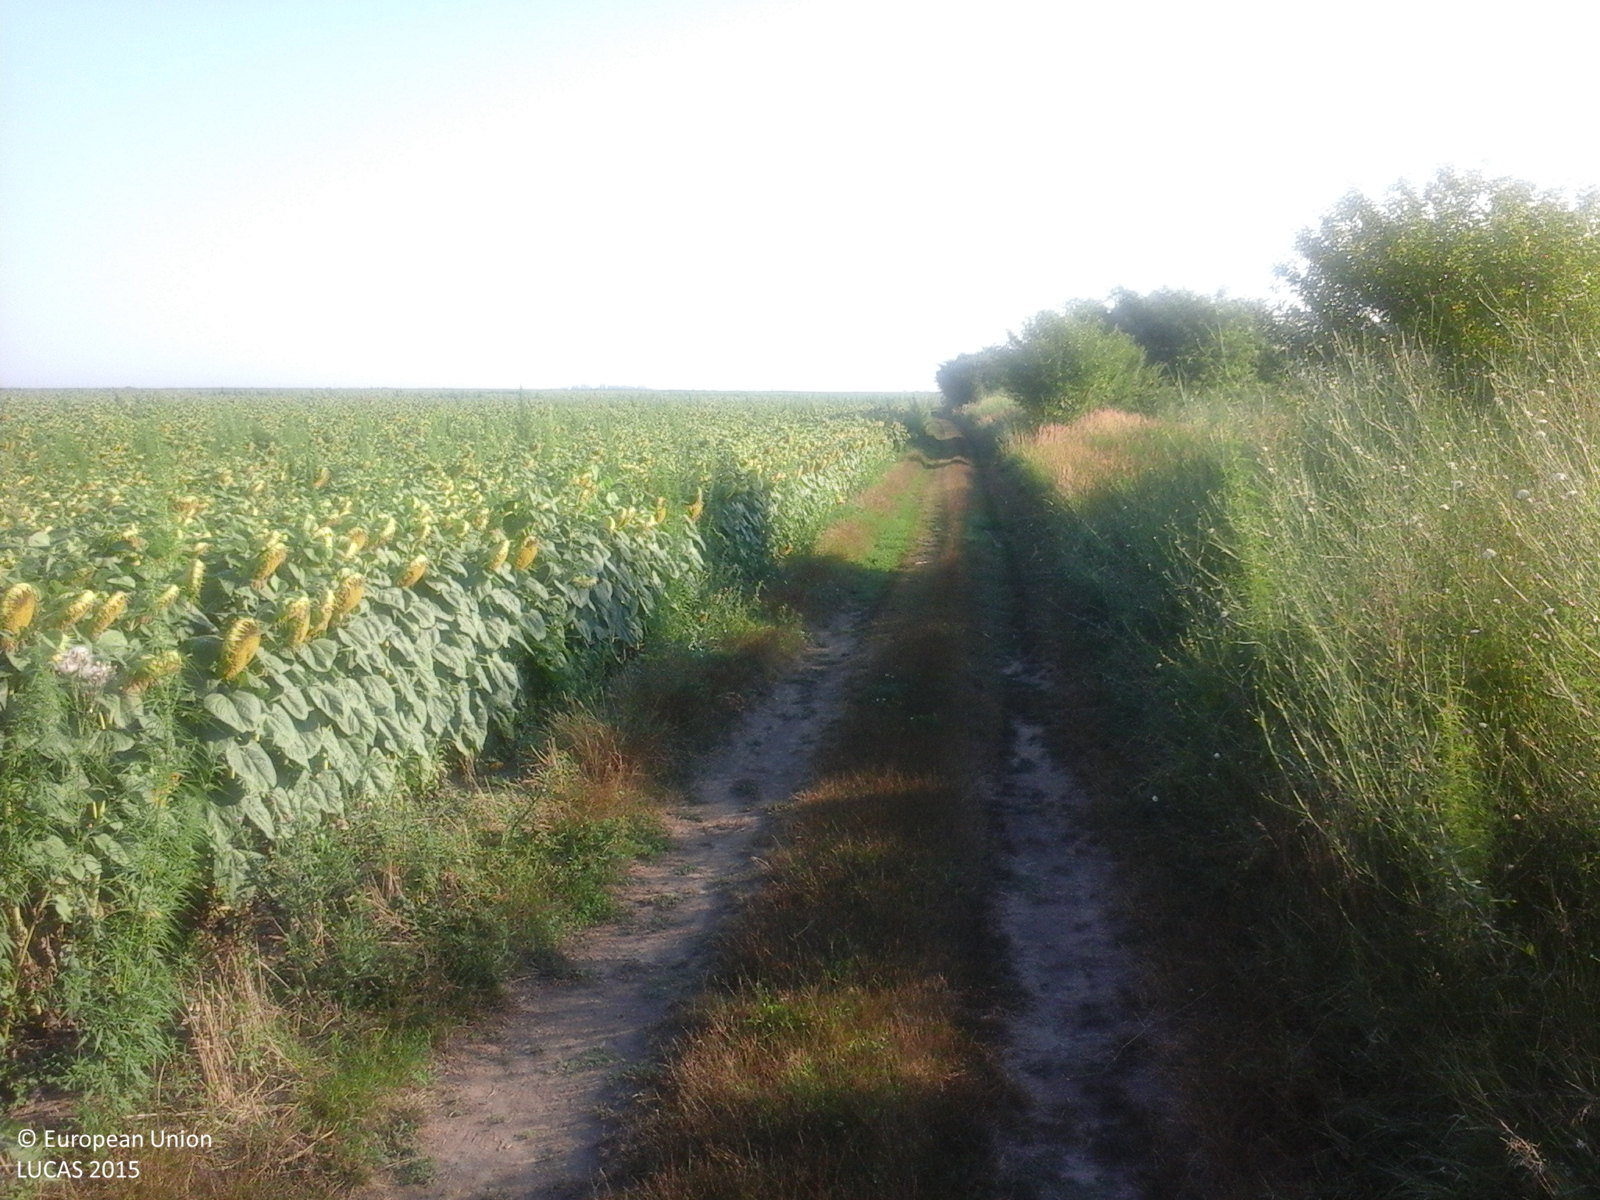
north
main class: Cropland
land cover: Sunflower
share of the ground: > 75 %
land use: Agriculture (excluding fallow land and kitchen gardens)
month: July
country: RO
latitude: 44.4982
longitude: 27.2267
